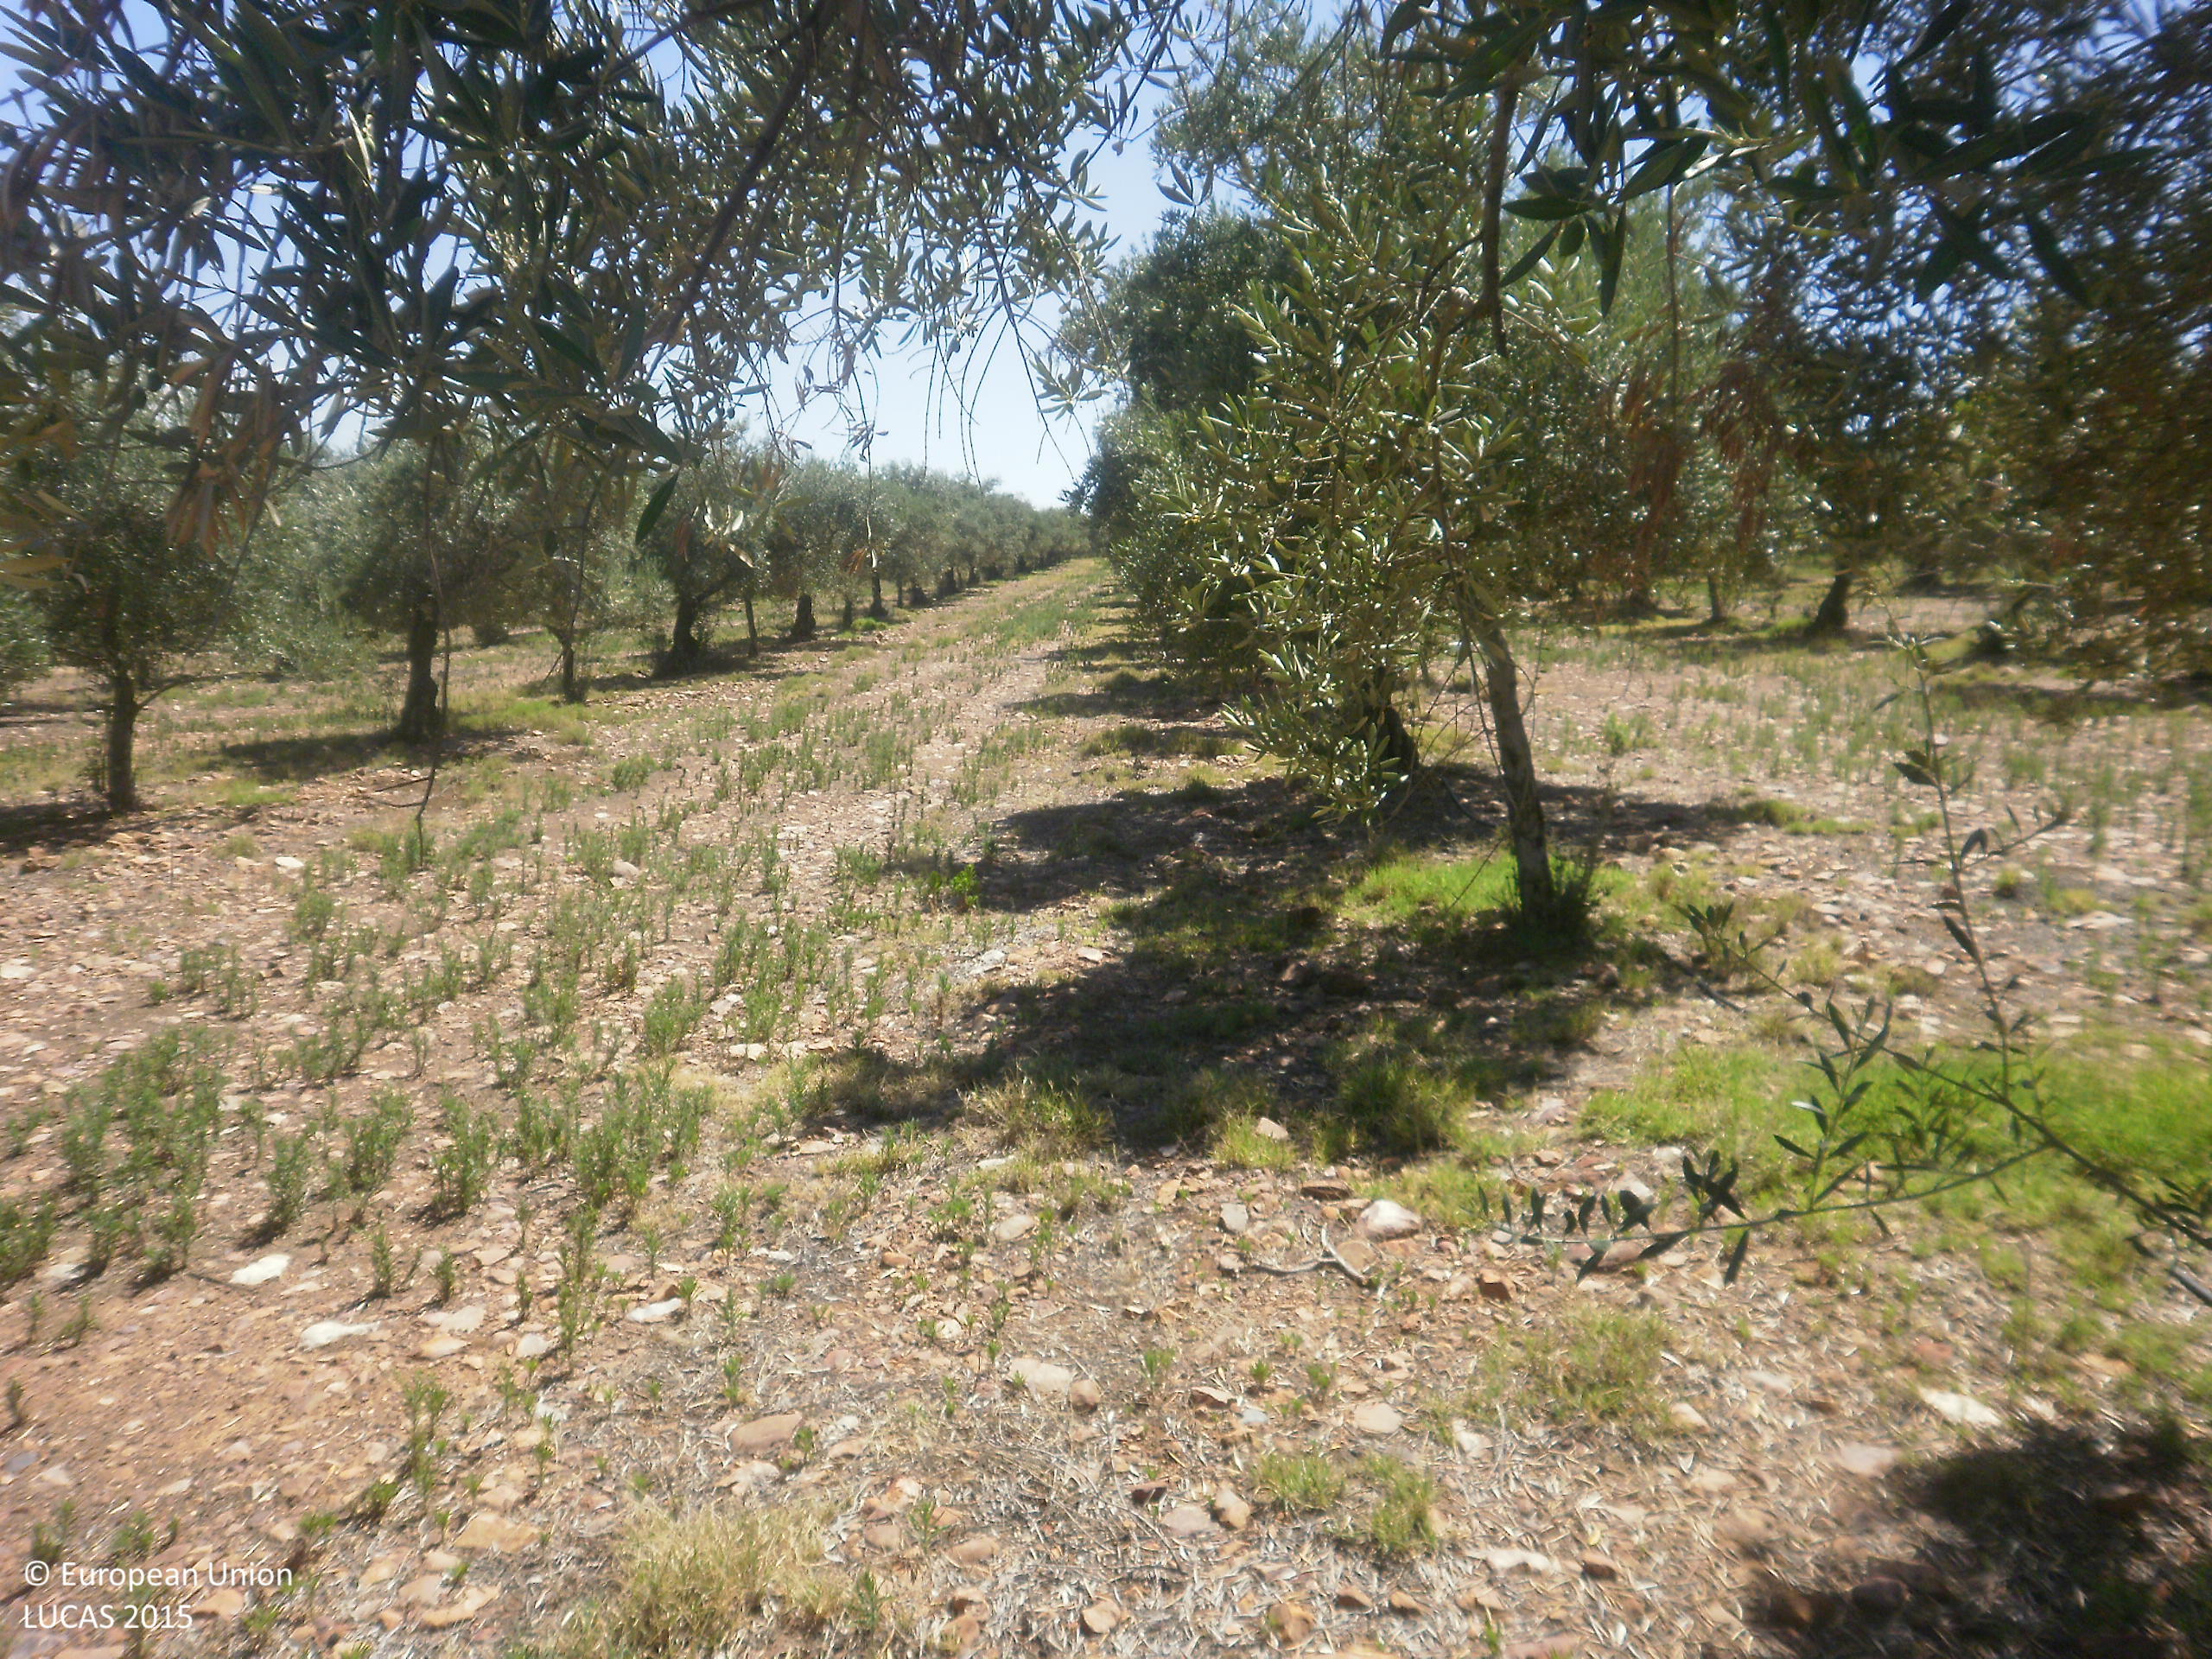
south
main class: Cropland
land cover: Olive groves
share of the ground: > 75 %
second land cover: Grassland without tree/shrub cover
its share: 50 - 75 %
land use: Agriculture (excluding fallow land and kitchen gardens)
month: June
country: ES
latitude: 38.6393
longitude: -5.3963
